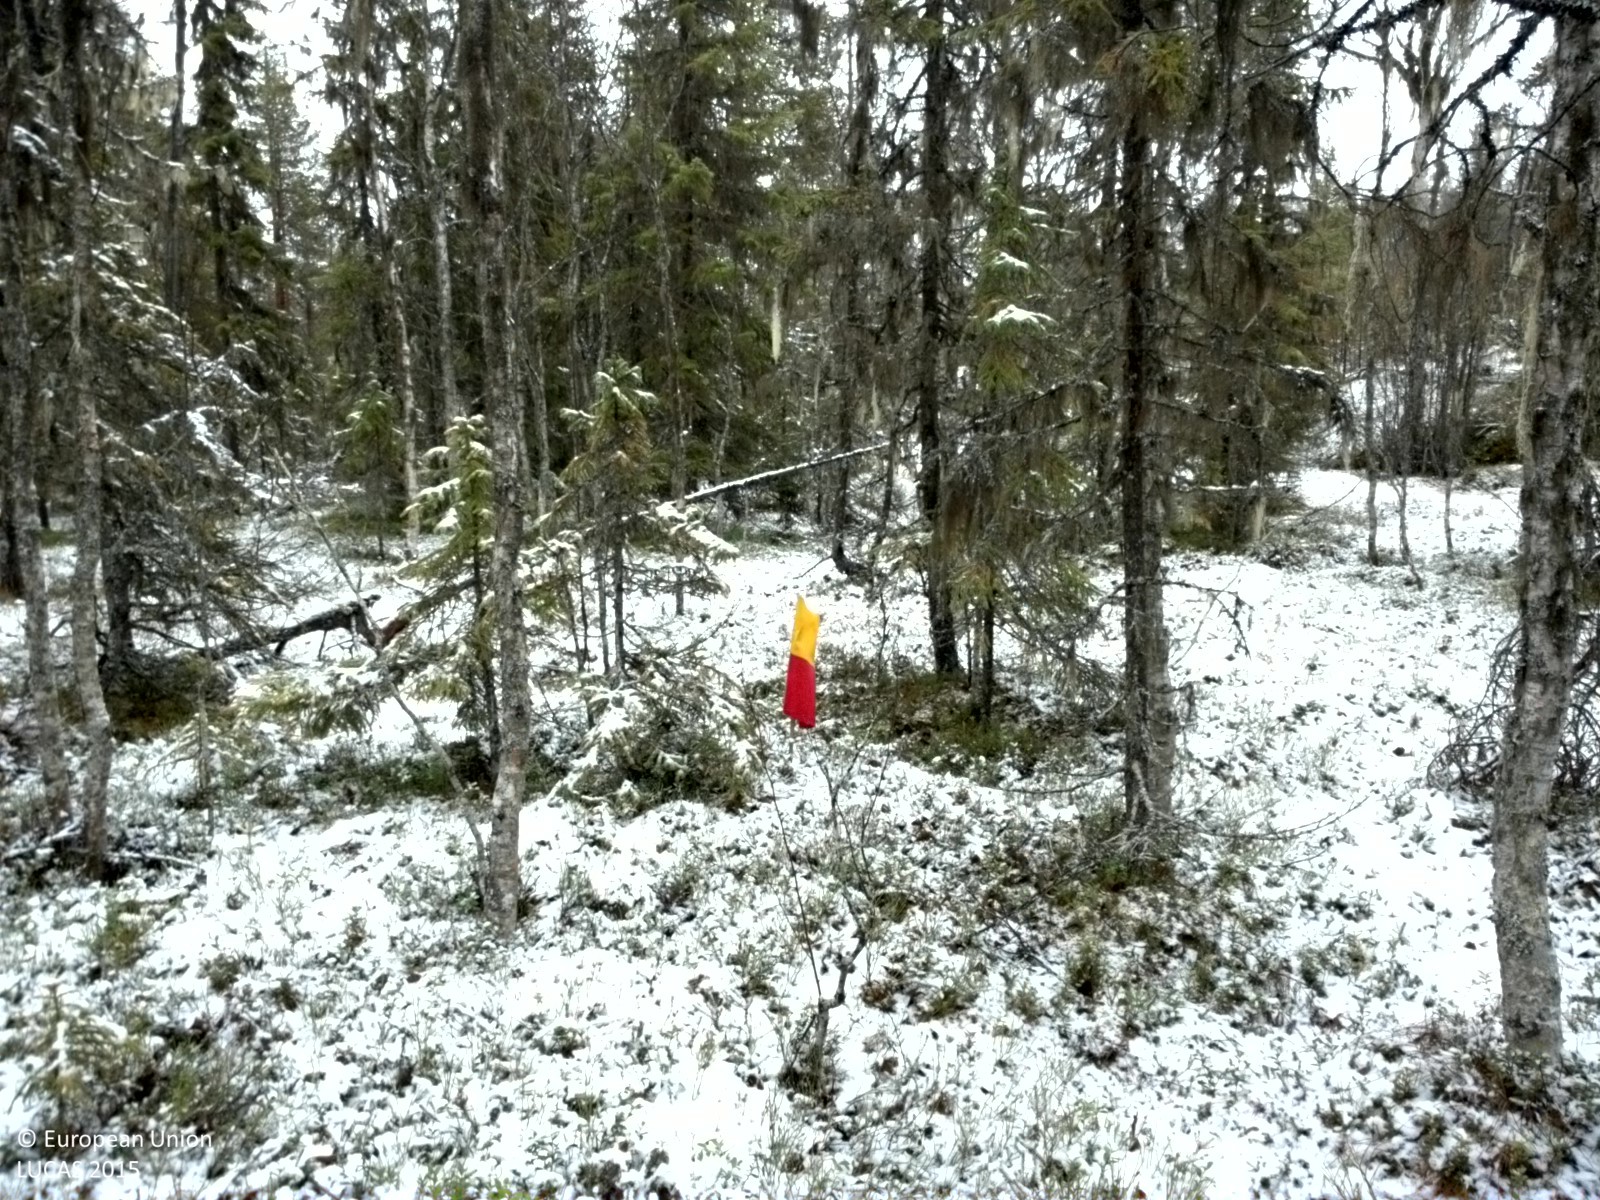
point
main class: Woodland
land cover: Spruce dominated mixed woodland
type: boreal forest
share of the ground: 25 - 50 %
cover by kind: shrubs 40 %, coniferous forest trees 30 %, lichens and mosses 15 %, broadleaved forest trees 10 %, herbaceous plants 5 %
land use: Forestry
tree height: > 5 m
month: November
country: SE
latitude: 63.9933
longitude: 16.0425
